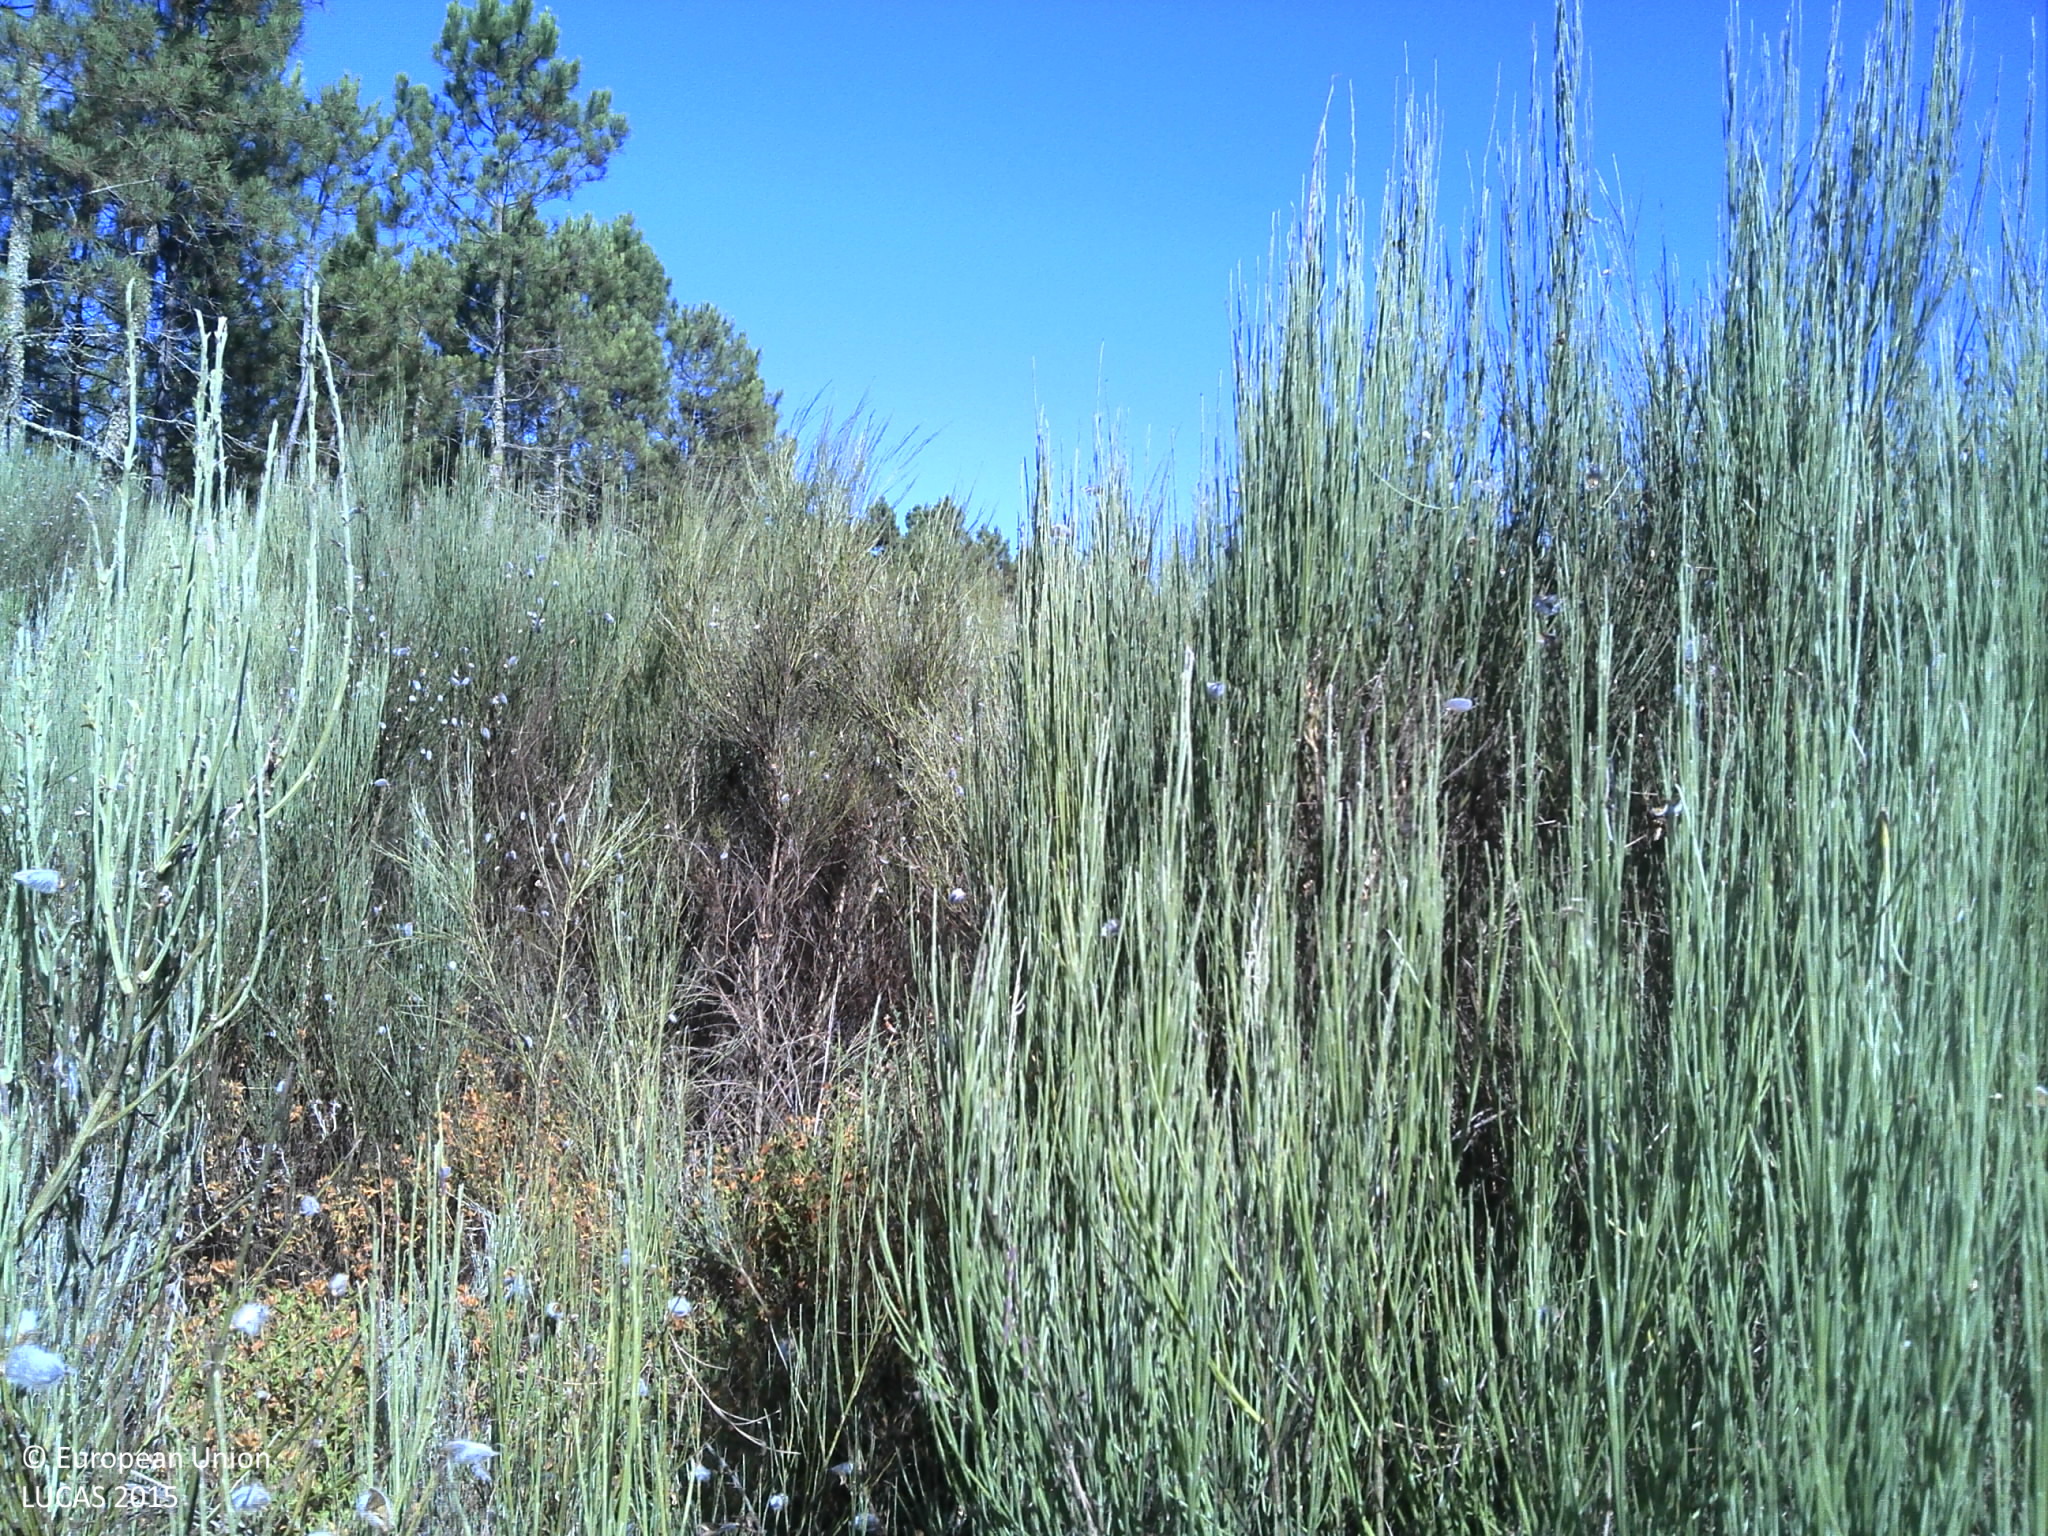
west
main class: Shrubland
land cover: Shrubland without tree cover
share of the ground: > 75 %
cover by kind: shrubs 100 %
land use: Semi-natural and natural areas not in use
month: July
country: PT
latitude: 41.3048
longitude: -7.4777
